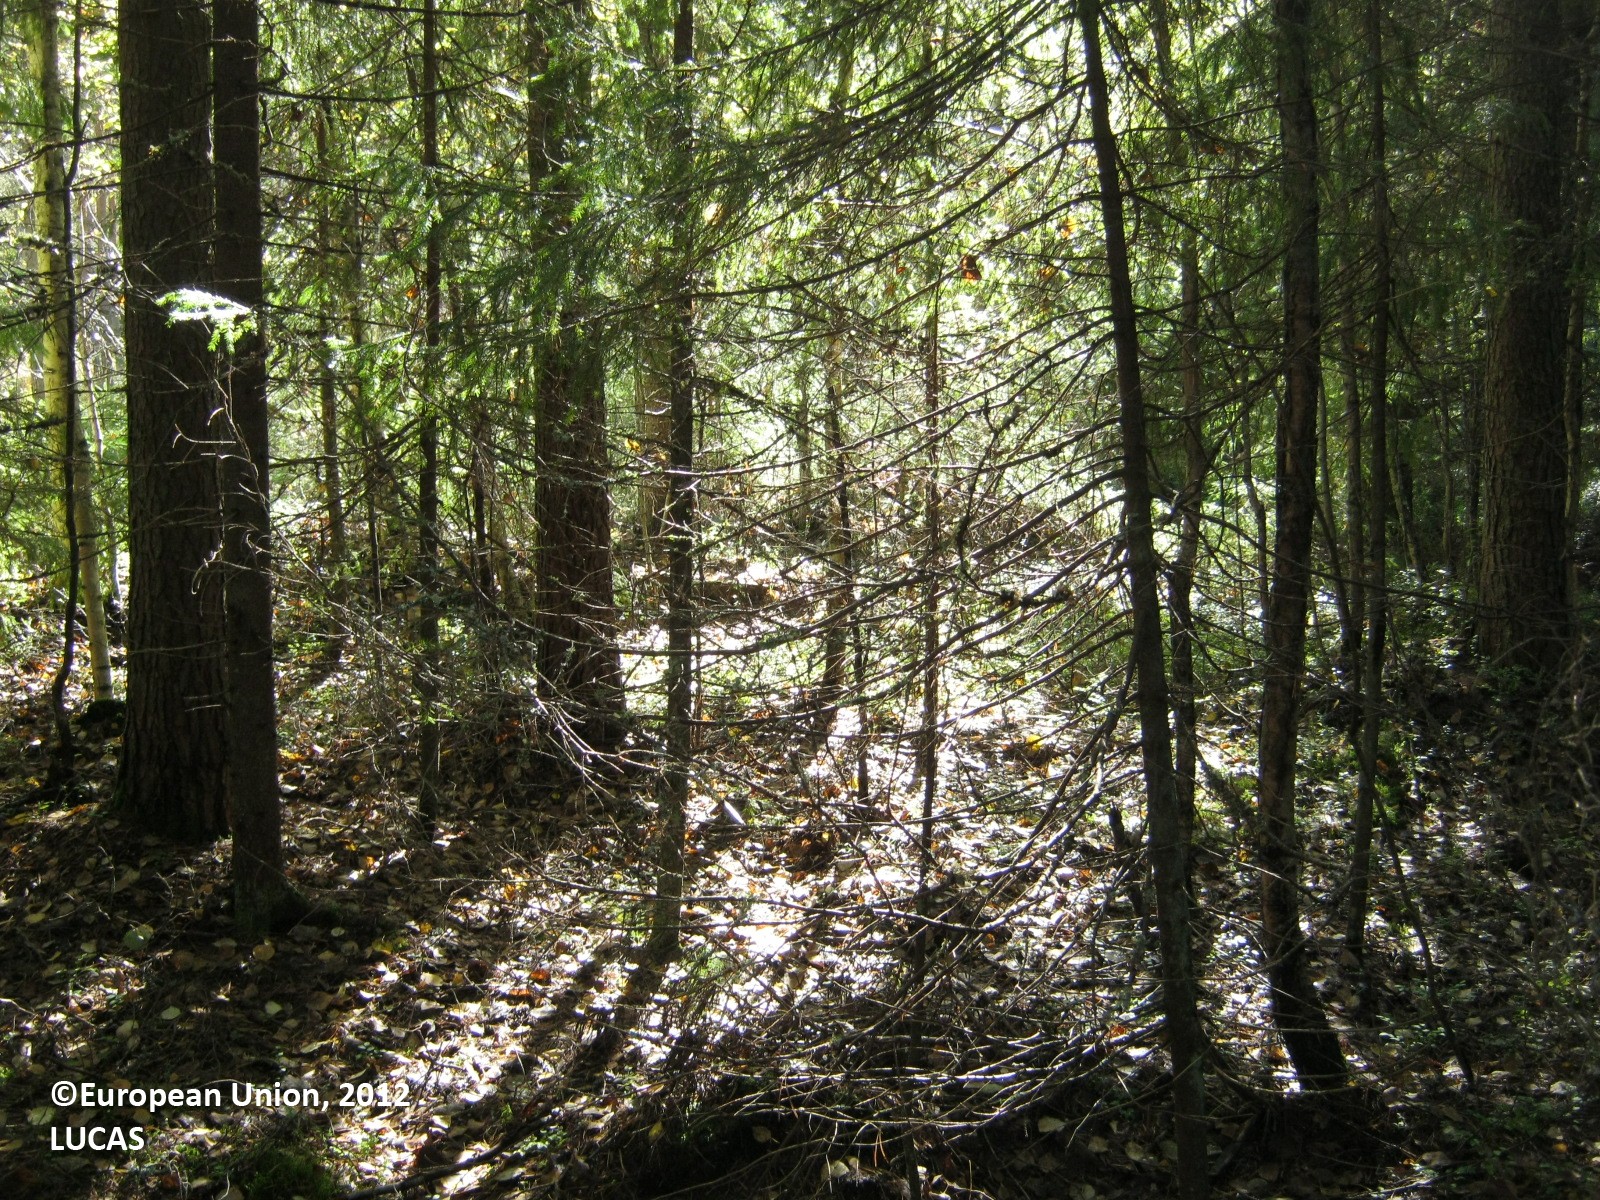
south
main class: Woodland
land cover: Other coniferous woodland
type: boreal forest
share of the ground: > 75 %
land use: Forestry
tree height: > 5 m
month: September
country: FI
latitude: 60.9309
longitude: 28.0430
